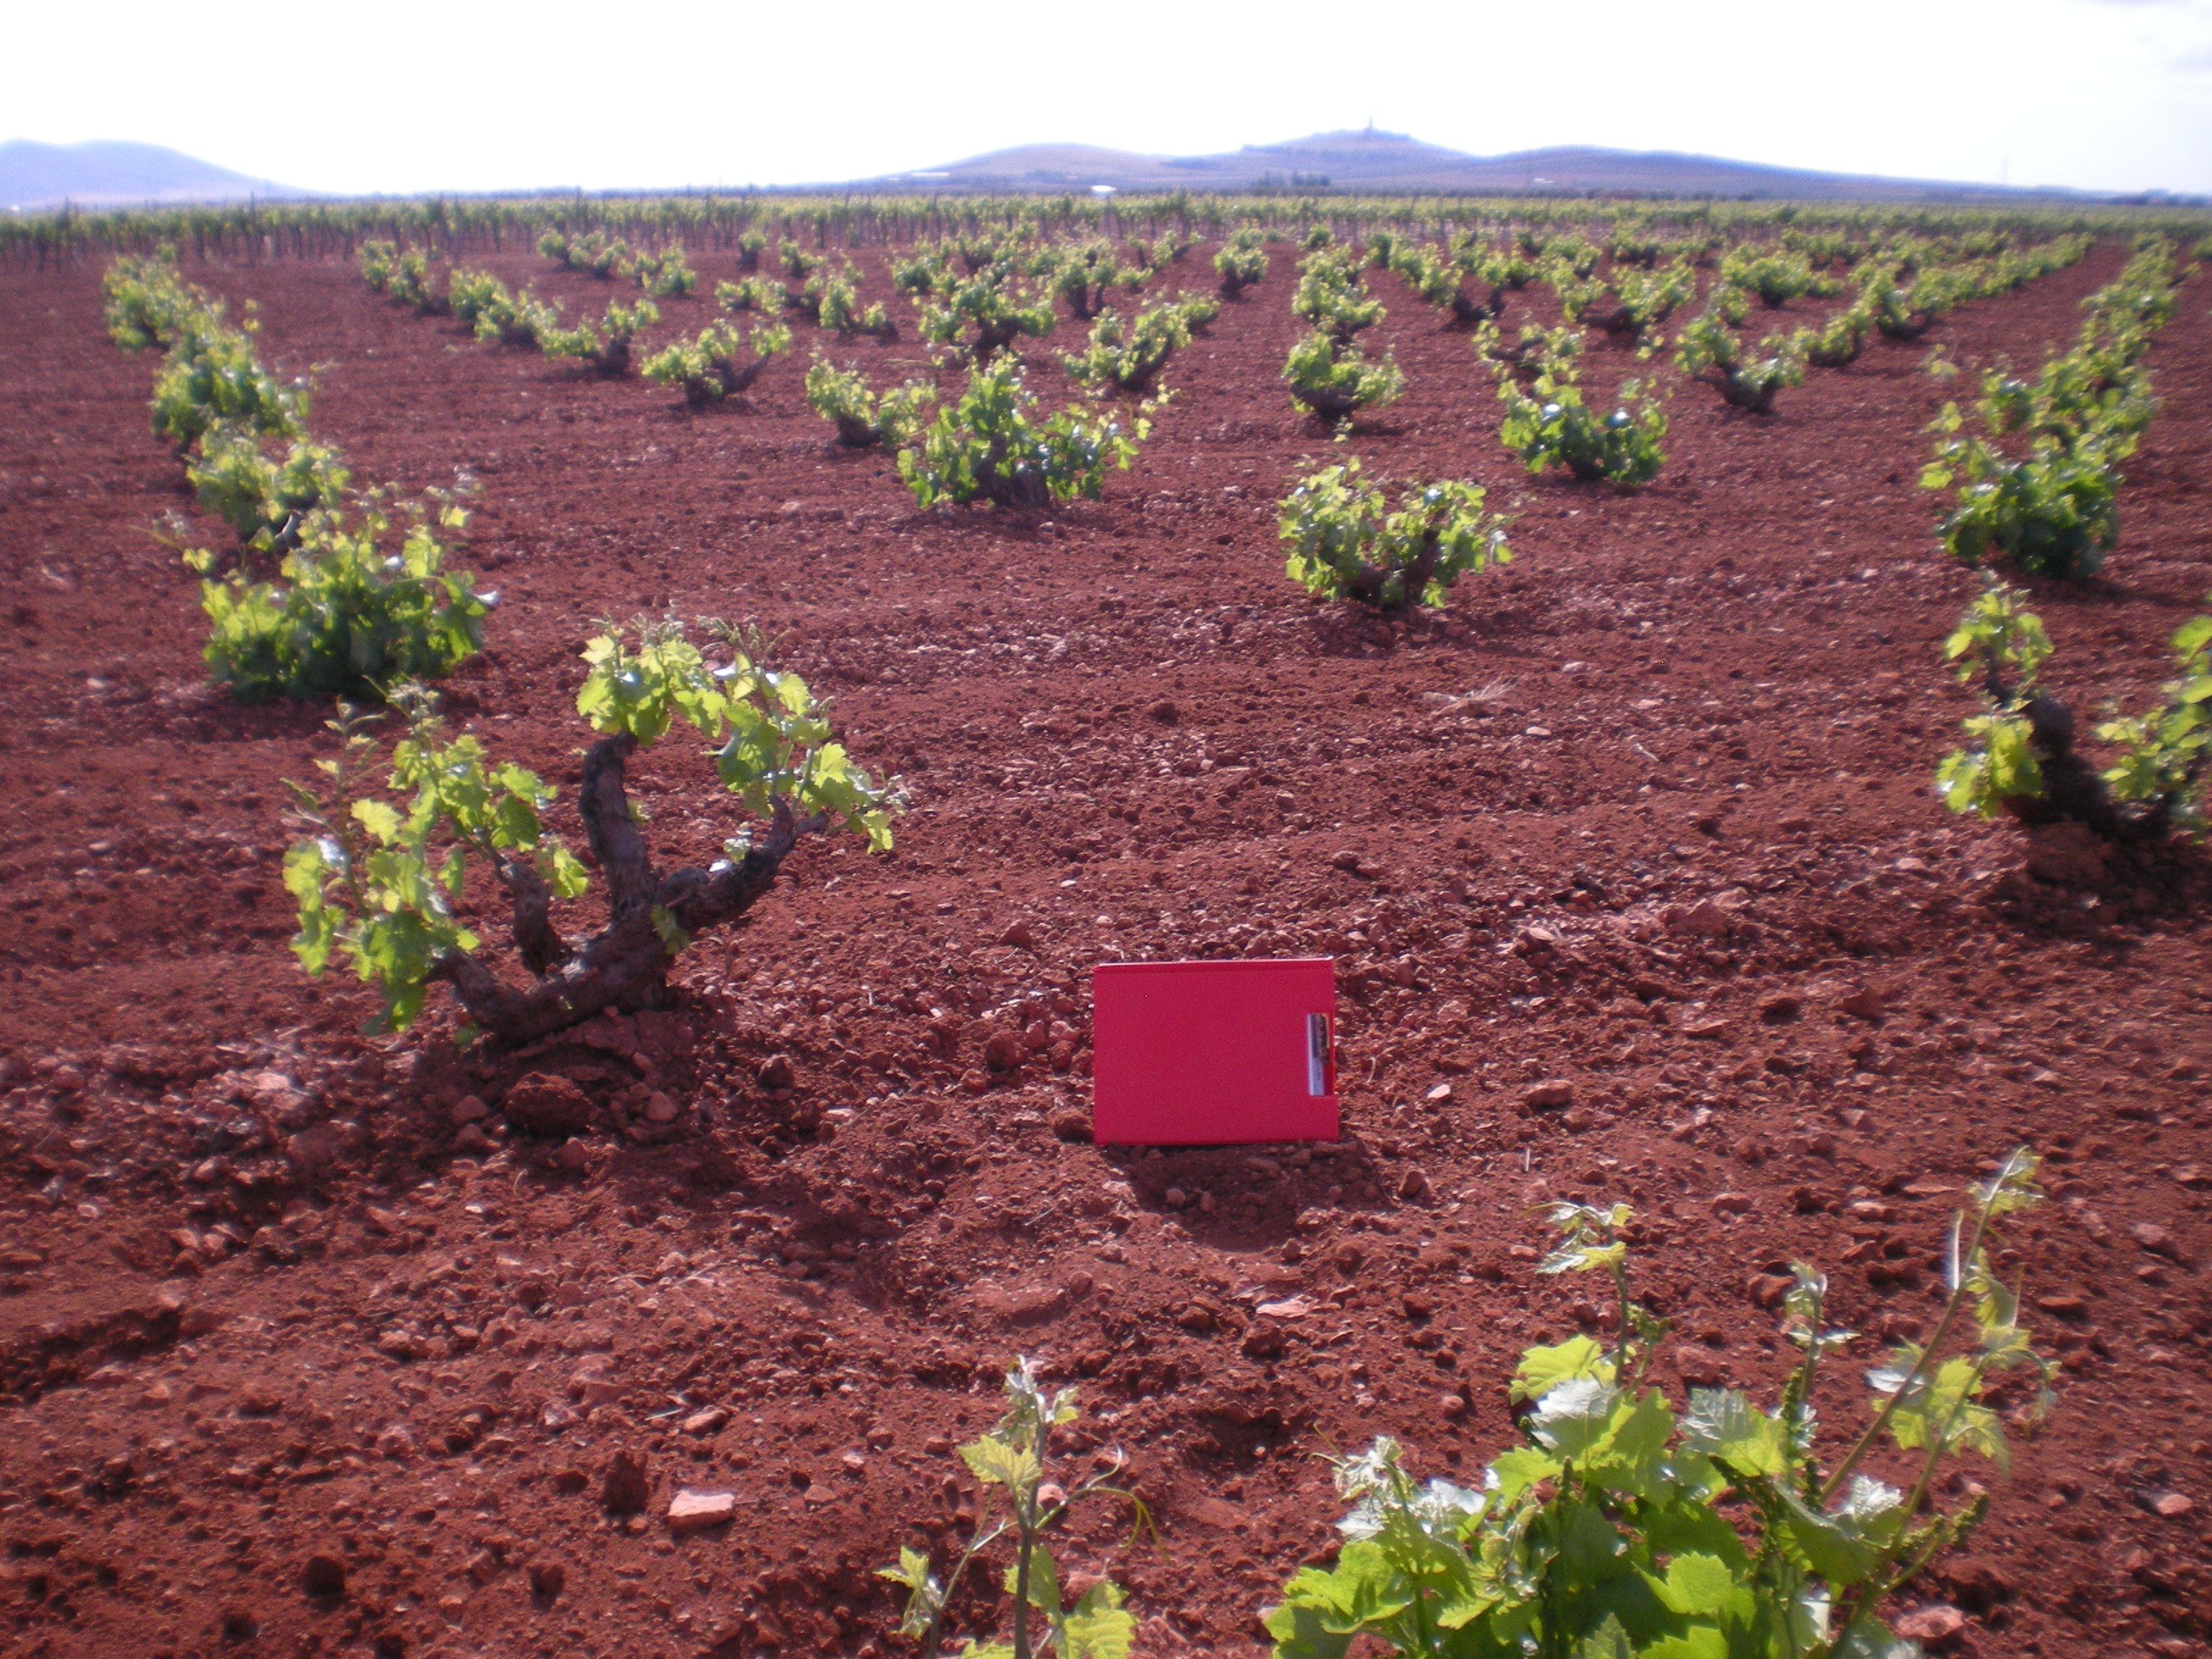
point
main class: Cropland
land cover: Vineyards
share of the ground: 10 - 25 %
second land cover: Other bare soil
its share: > 75 %
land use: Agriculture (excluding fallow land and kitchen gardens)
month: May
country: ES
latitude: 38.8083
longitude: -3.4279
